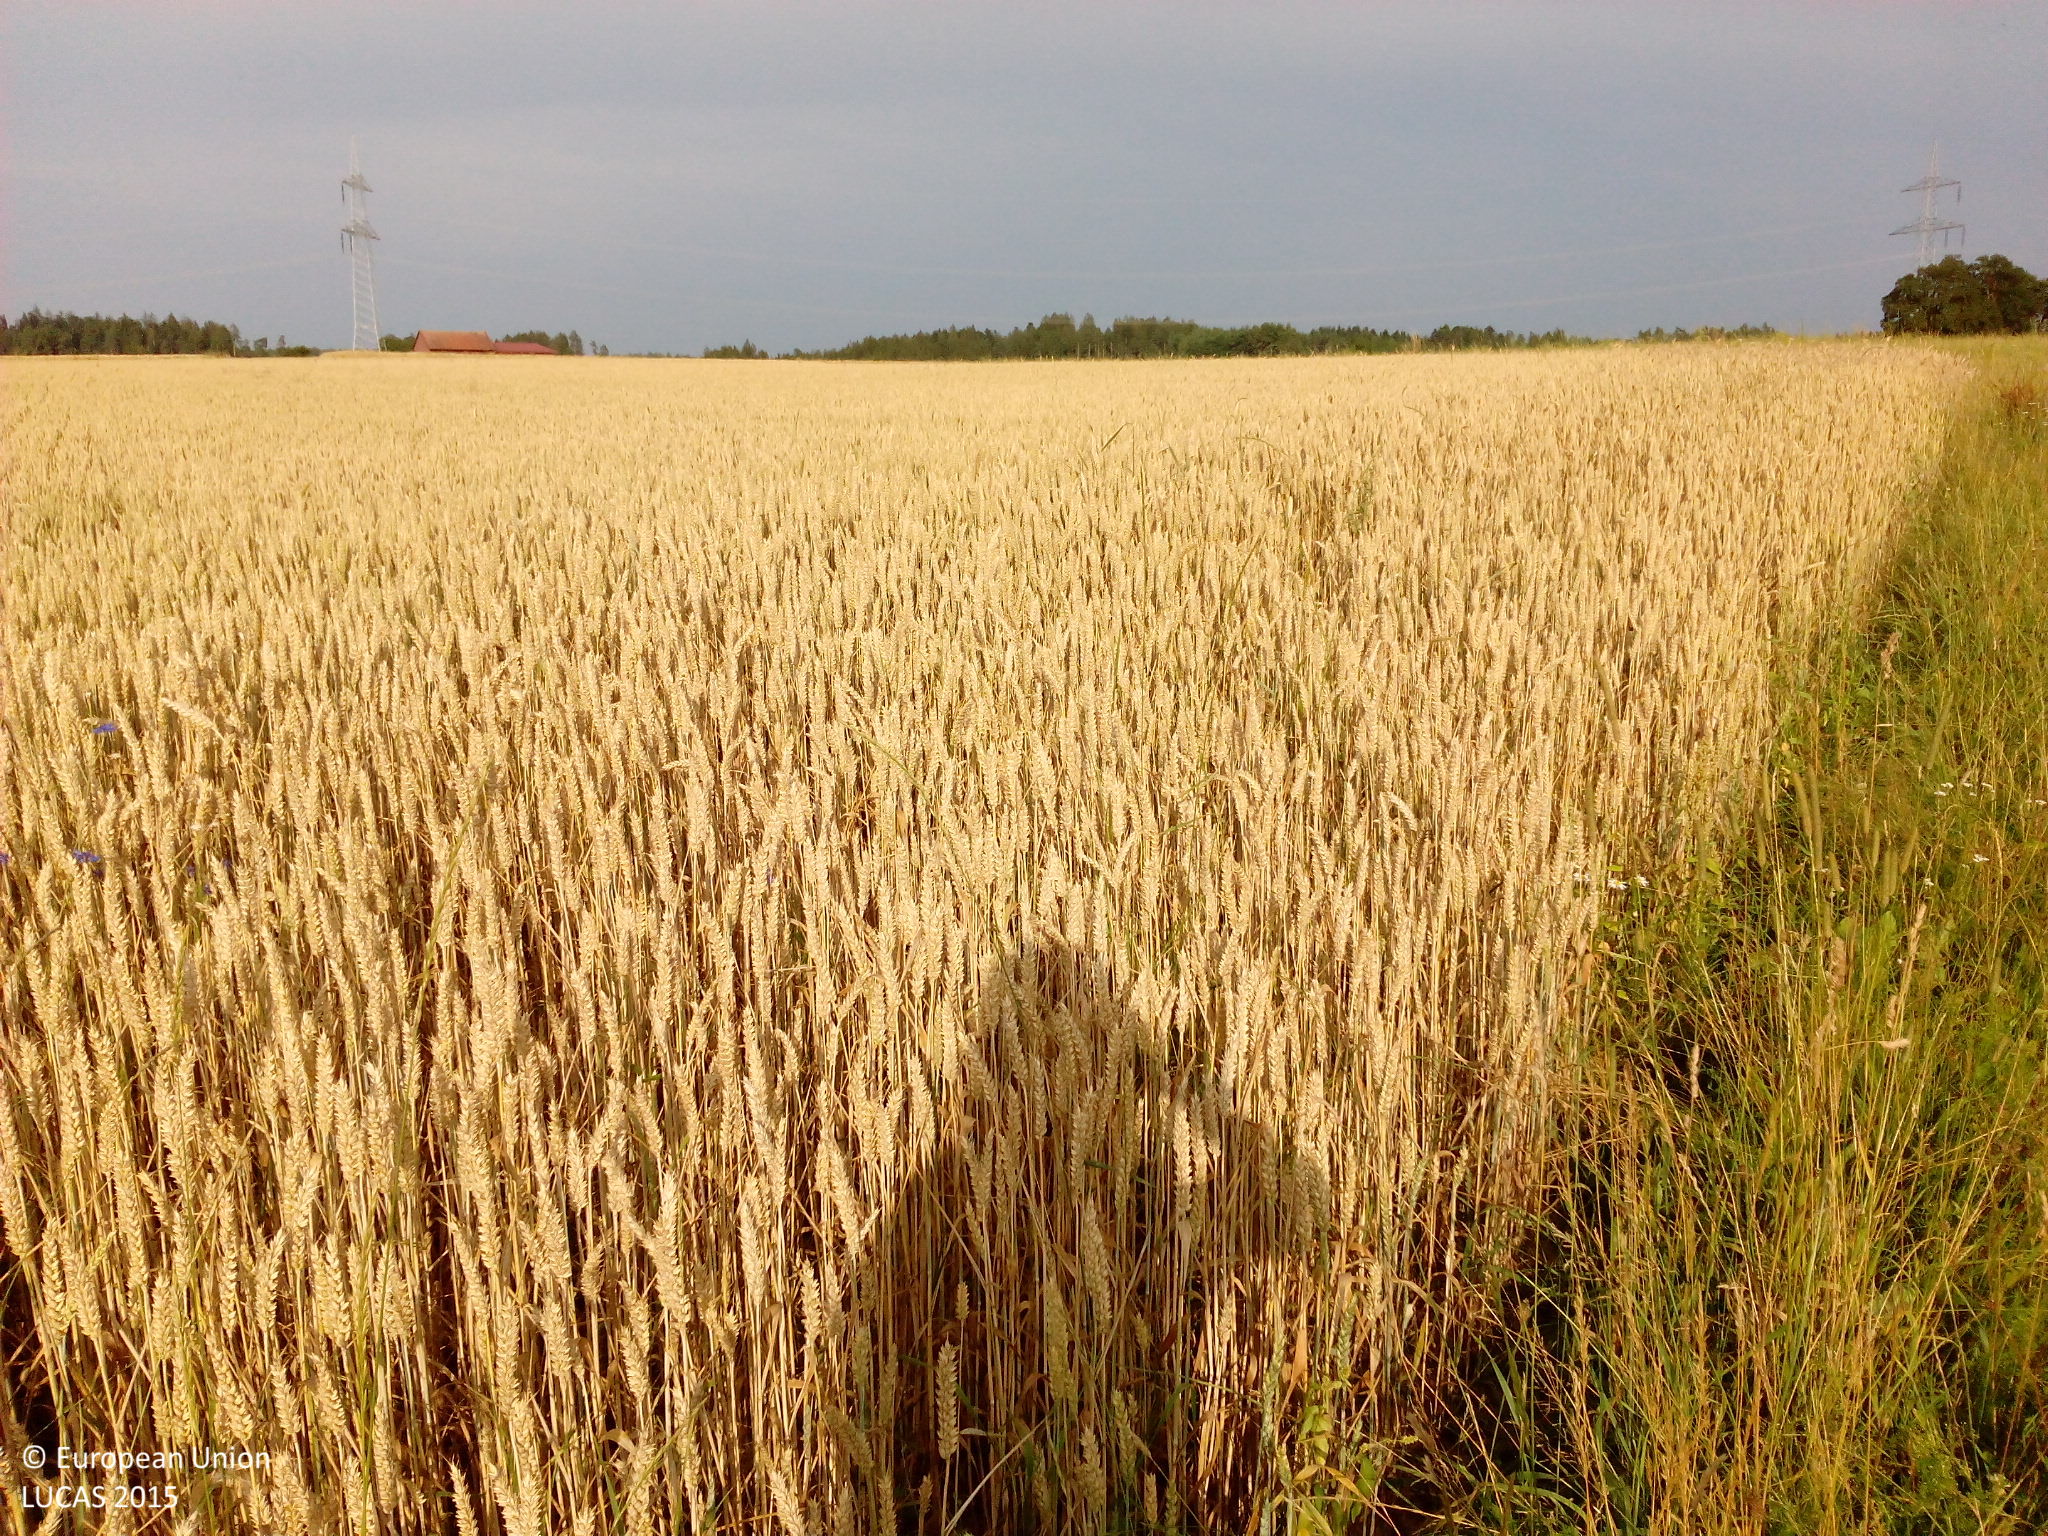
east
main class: Cropland
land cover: Common wheat
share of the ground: > 75 %
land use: Agriculture (excluding fallow land and kitchen gardens)
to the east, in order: Common wheat; Grassland without tree/shrub cover; Tracks; Common wheat; Grassland without tree/shrub cover
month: July
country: DE
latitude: 49.0332
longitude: 9.9590
